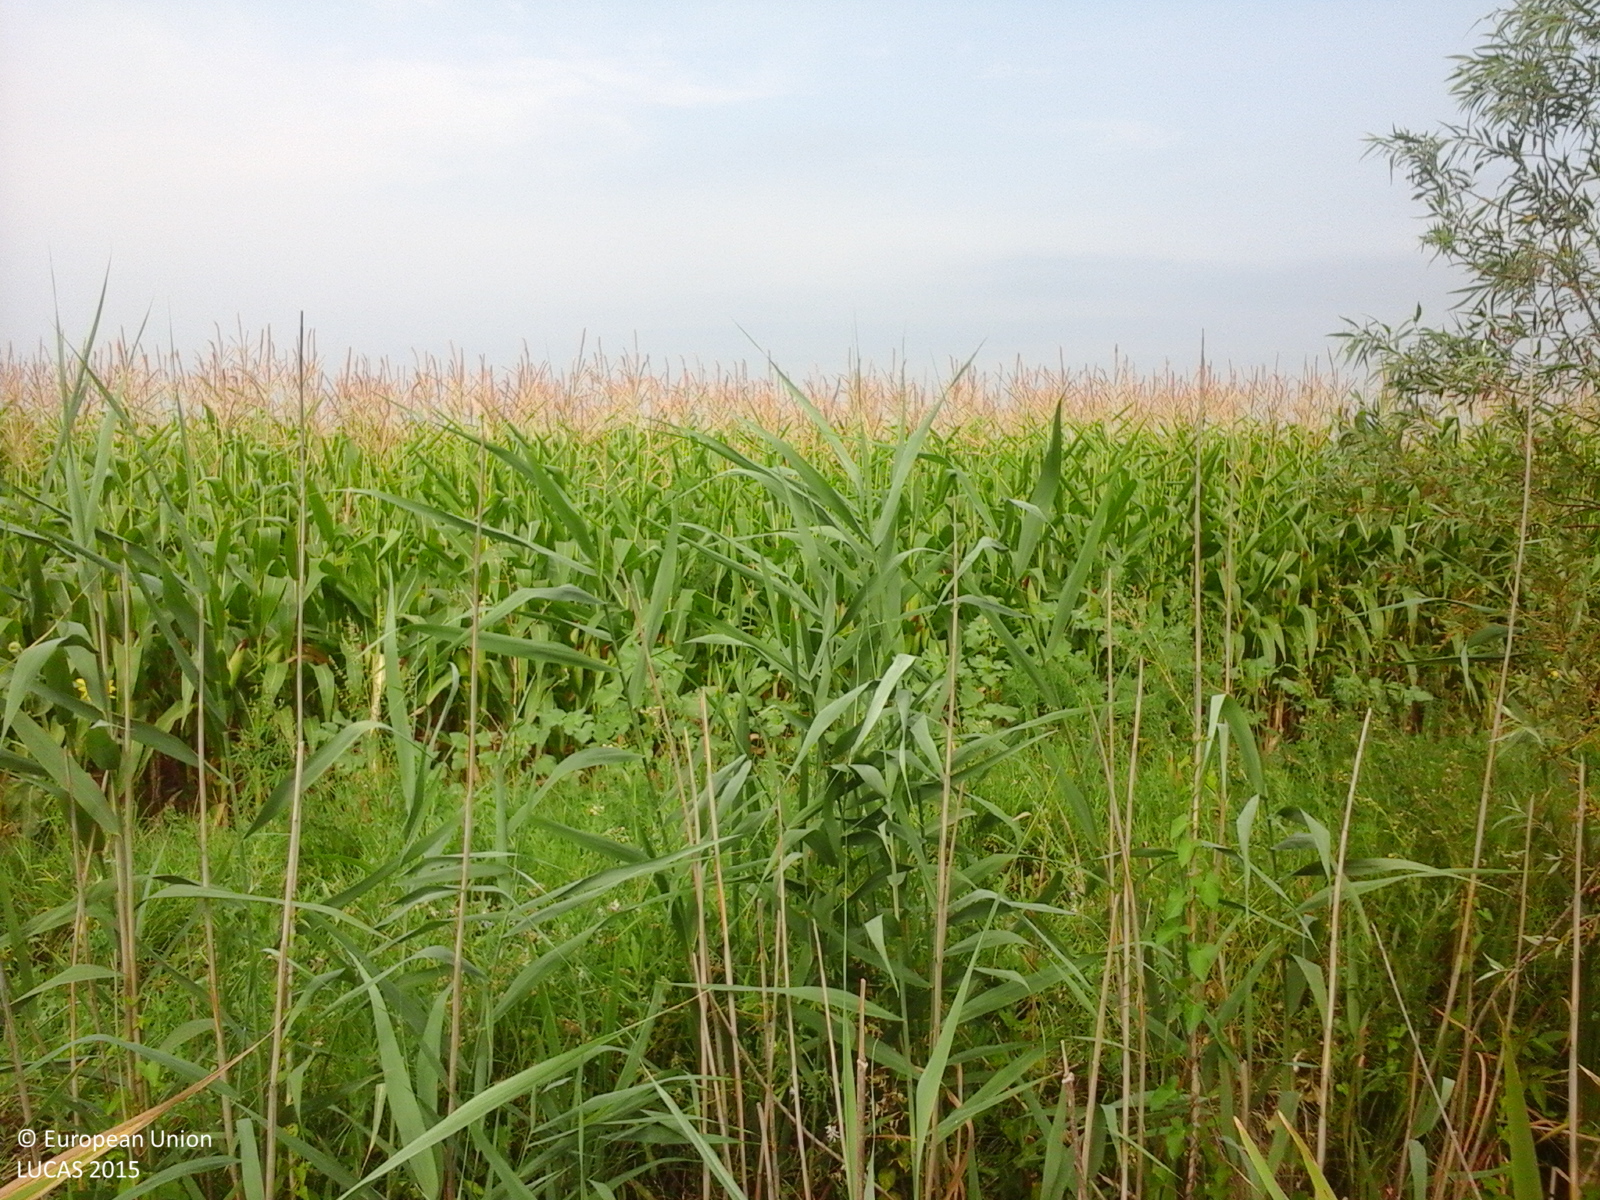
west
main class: Cropland
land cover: Maize
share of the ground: > 75 %
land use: Agriculture (excluding fallow land and kitchen gardens)
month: July
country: RO
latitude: 45.3781
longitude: 28.1132
